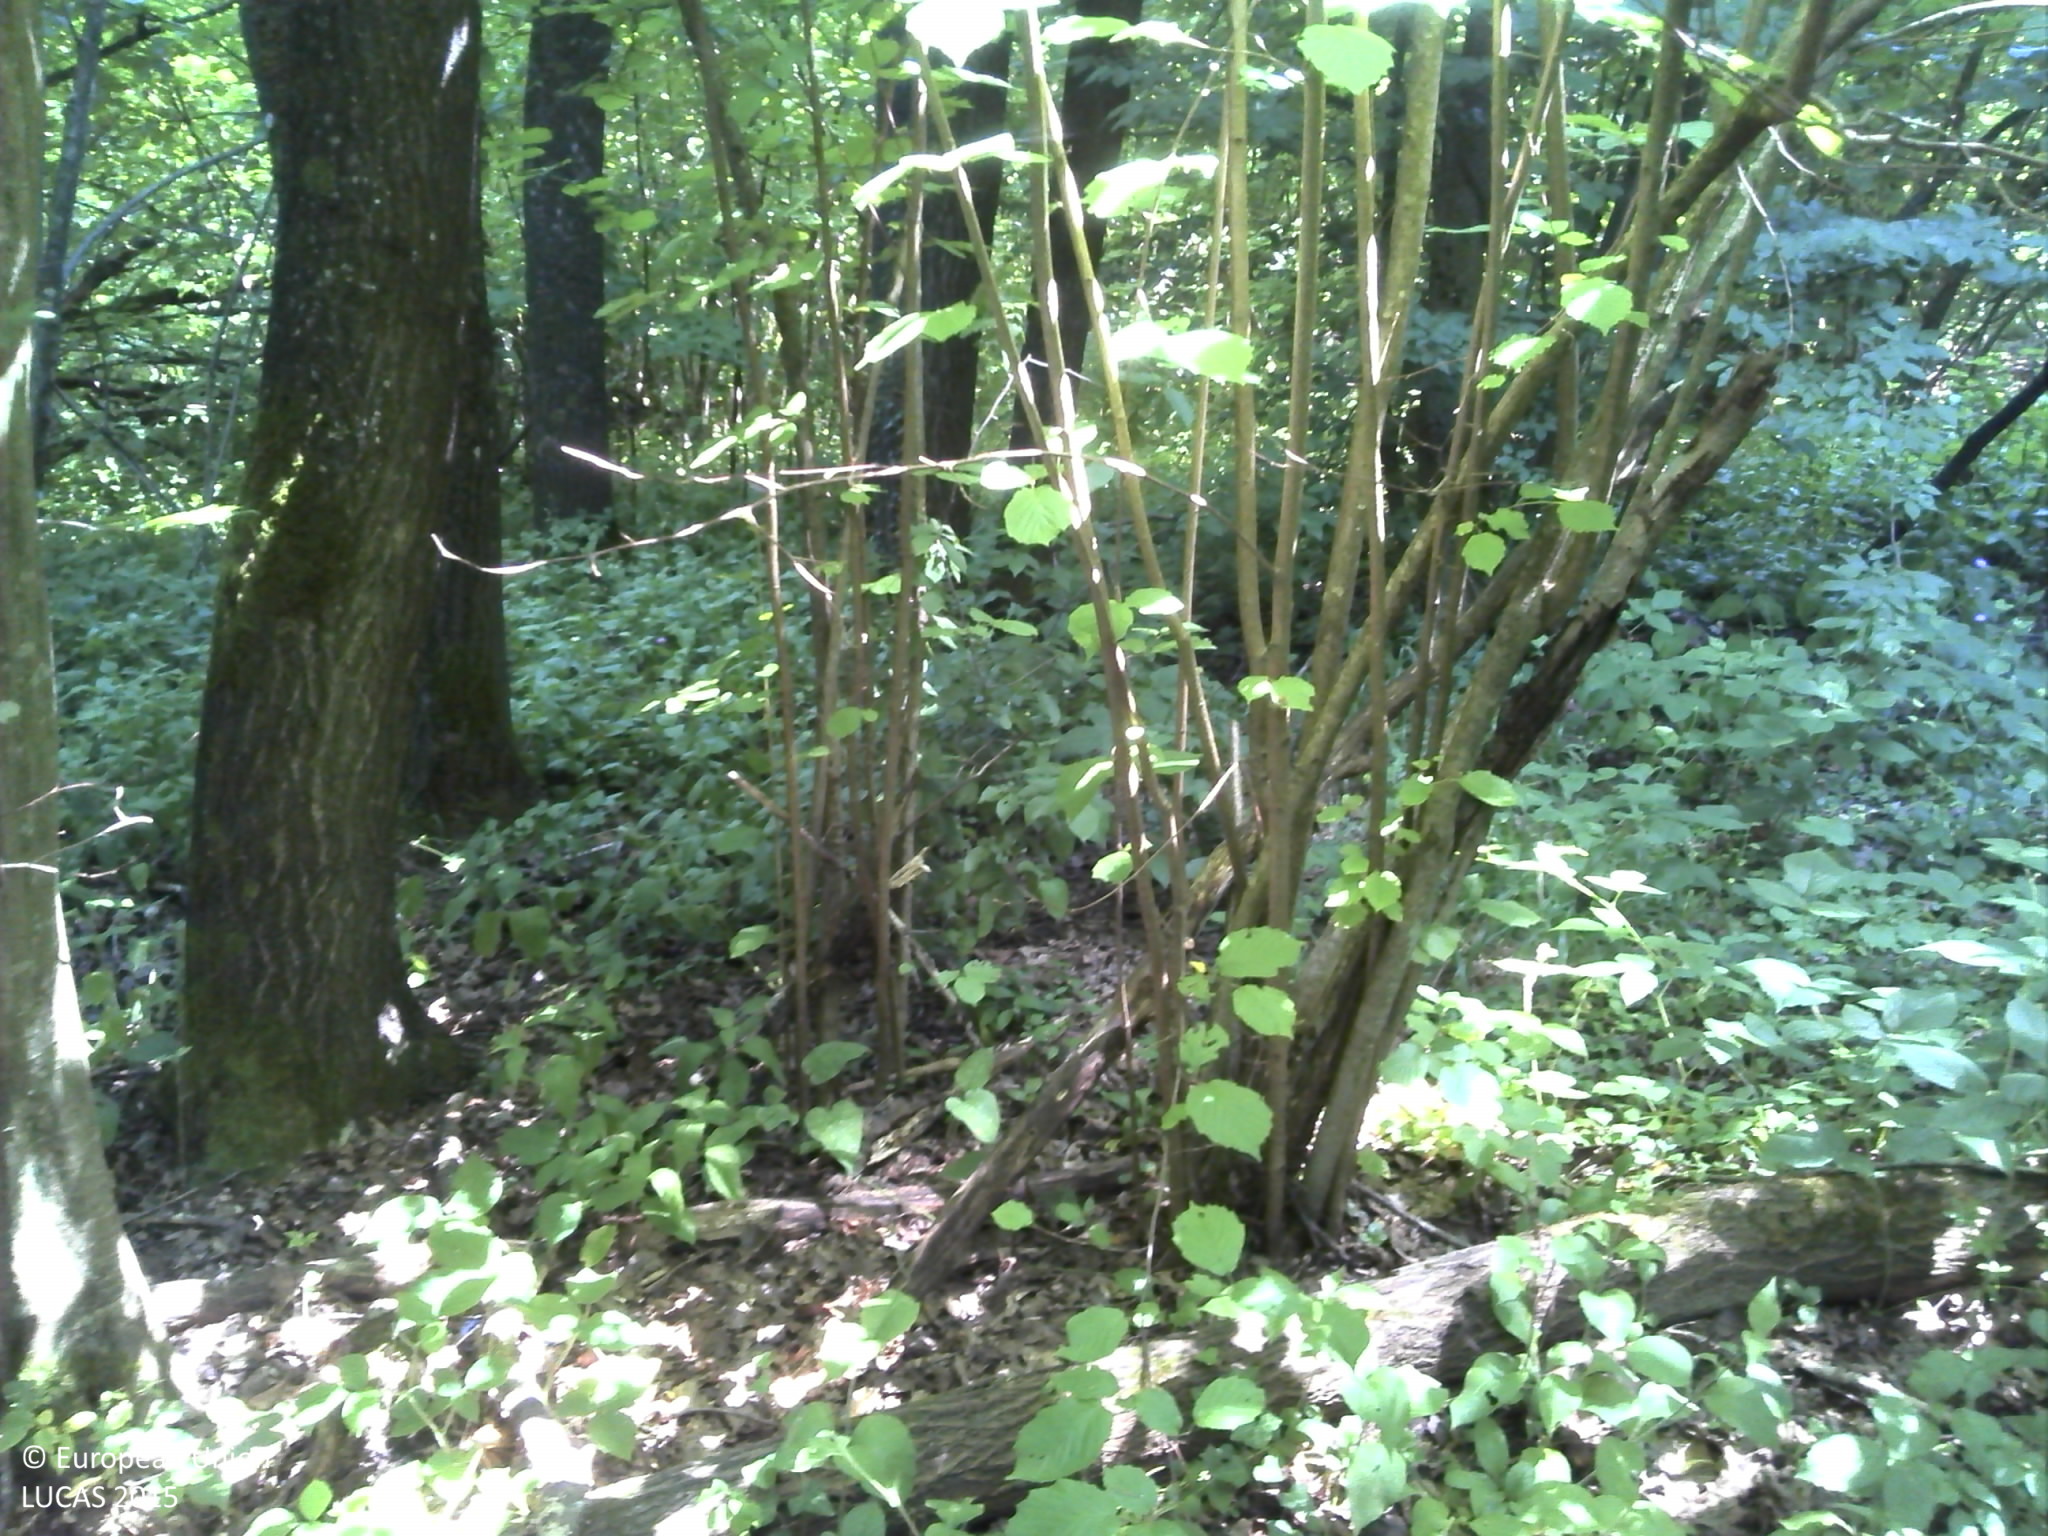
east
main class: Woodland
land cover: Broadleaved woodland
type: acidophilous oak and oak-birch forest
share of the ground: > 75 %
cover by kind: broadleaved forest trees 90 %, shrubs 5 %, herbaceous plants 5 %
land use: Forestry
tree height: > 5 m
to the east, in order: Broadleaved woodland; Tracks; Spontaneously vegetated surfaces; Shrubland with sparse tree cover; Spontaneously vegetated surfaces
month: July
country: HR
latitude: 45.7421
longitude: 16.7216
